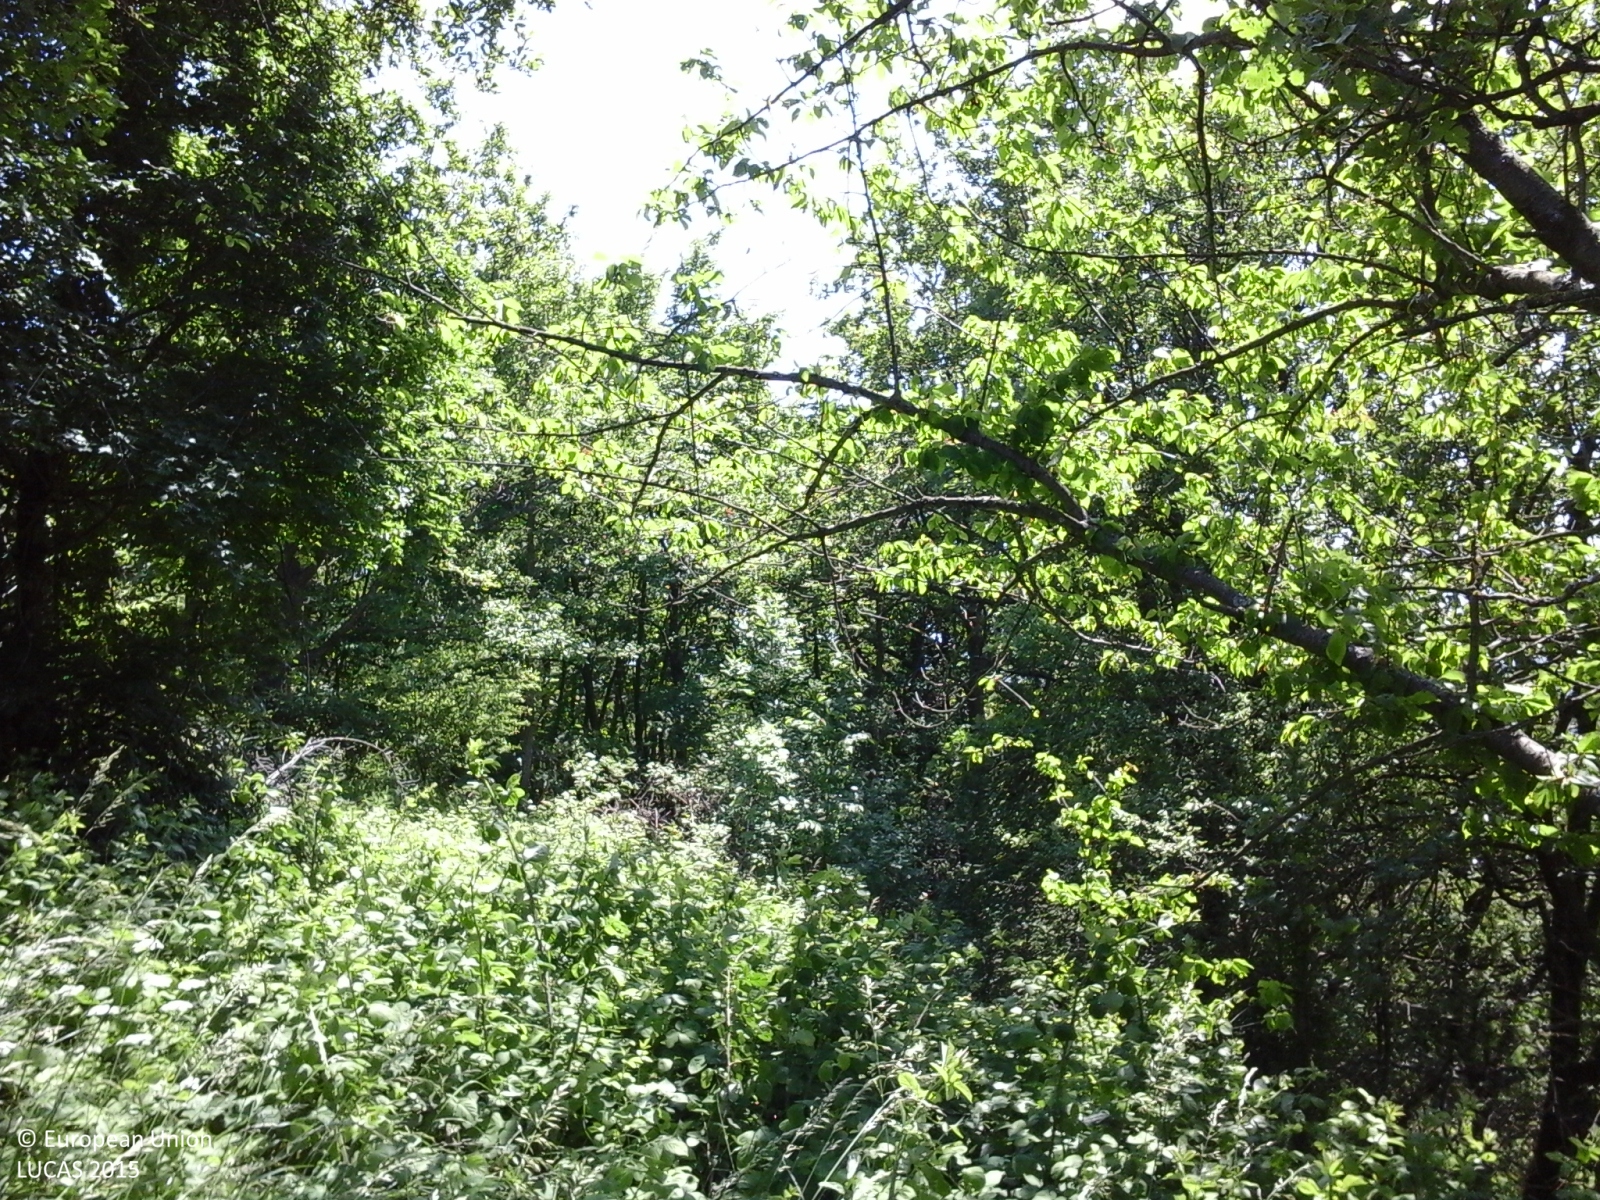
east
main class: Woodland
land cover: Broadleaved woodland
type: thermophilous deciduous forest
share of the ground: > 75 %
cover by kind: broadleaved forest trees 100 %
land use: Forestry
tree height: > 5 m
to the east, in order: Broadleaved woodland; Arable land (only in case pi); Broadleaved woodland
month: May
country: IT
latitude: 44.7473
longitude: 9.9118
